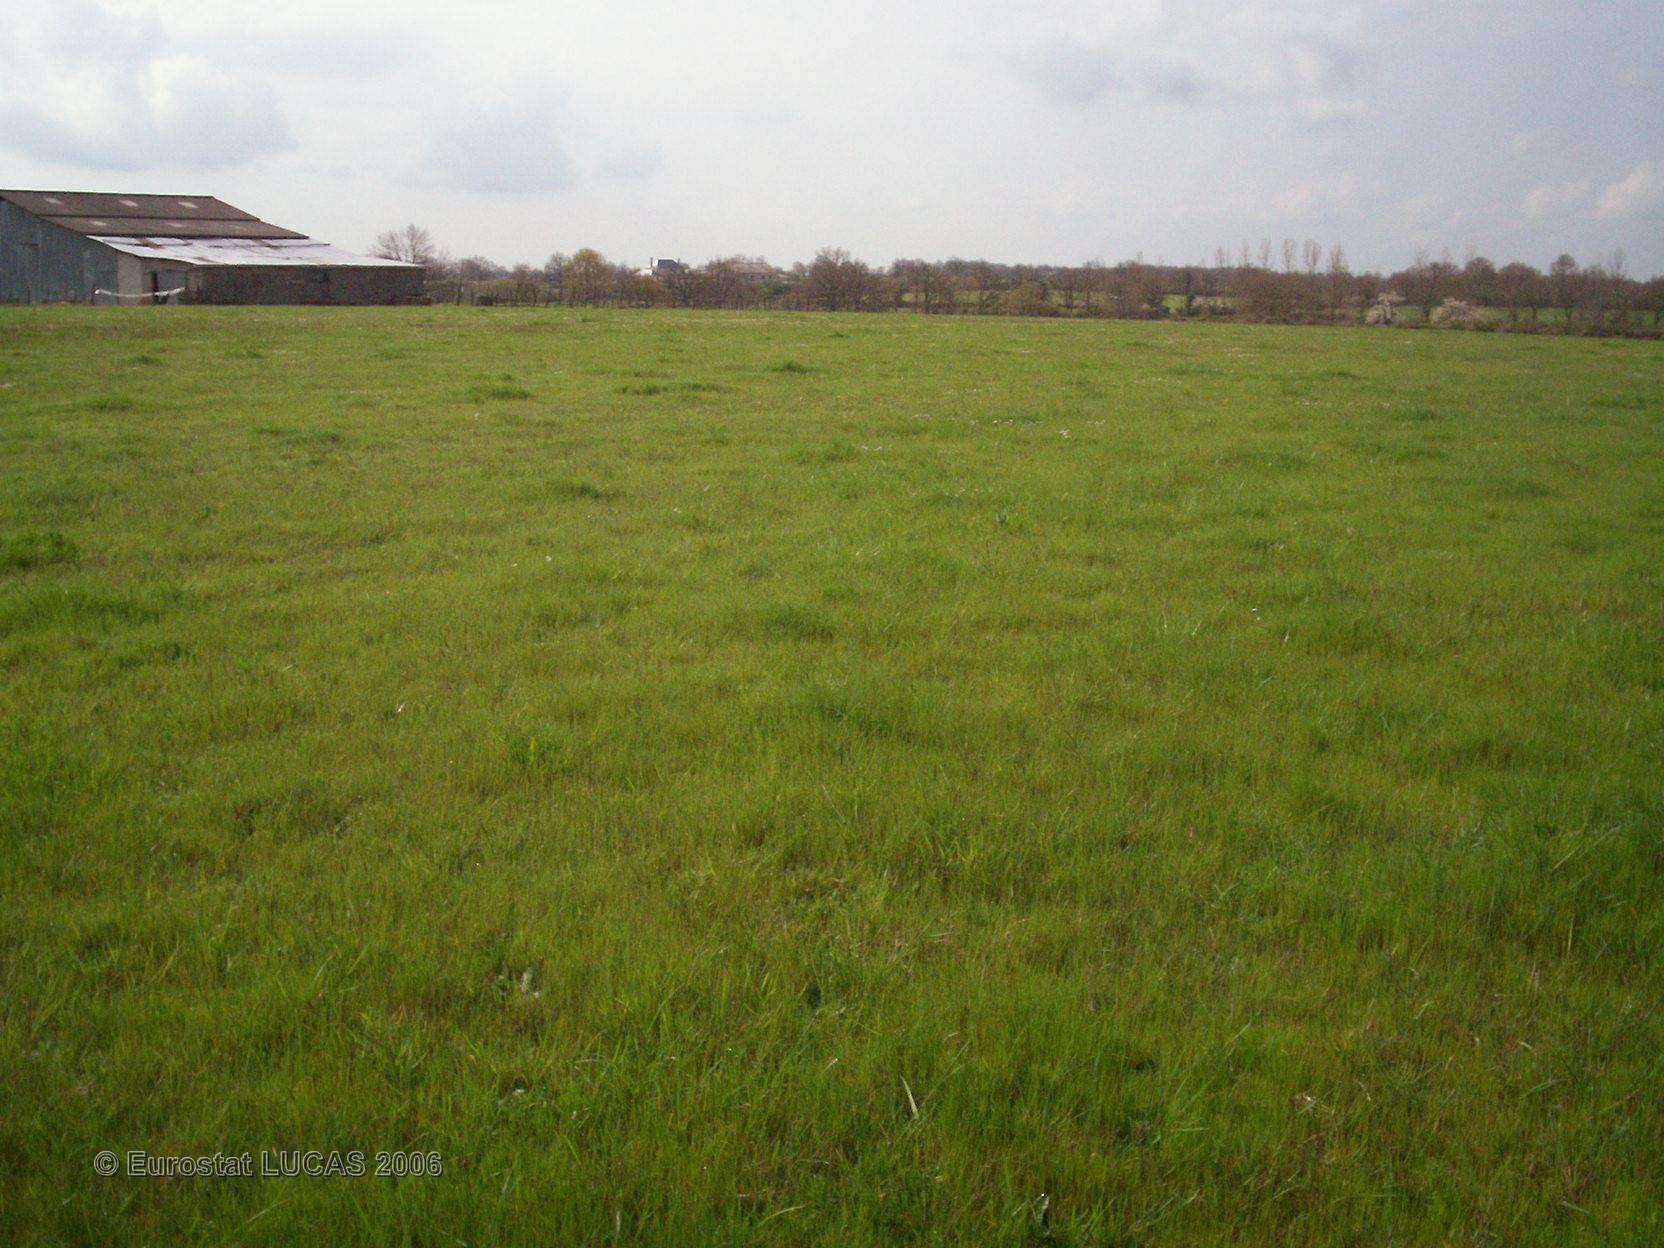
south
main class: Grassland
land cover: Grassland without tree/shrub cover
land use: Agriculture (excluding fallow land and kitchen gardens)
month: April
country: FR
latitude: 46.8794
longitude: -0.3801
